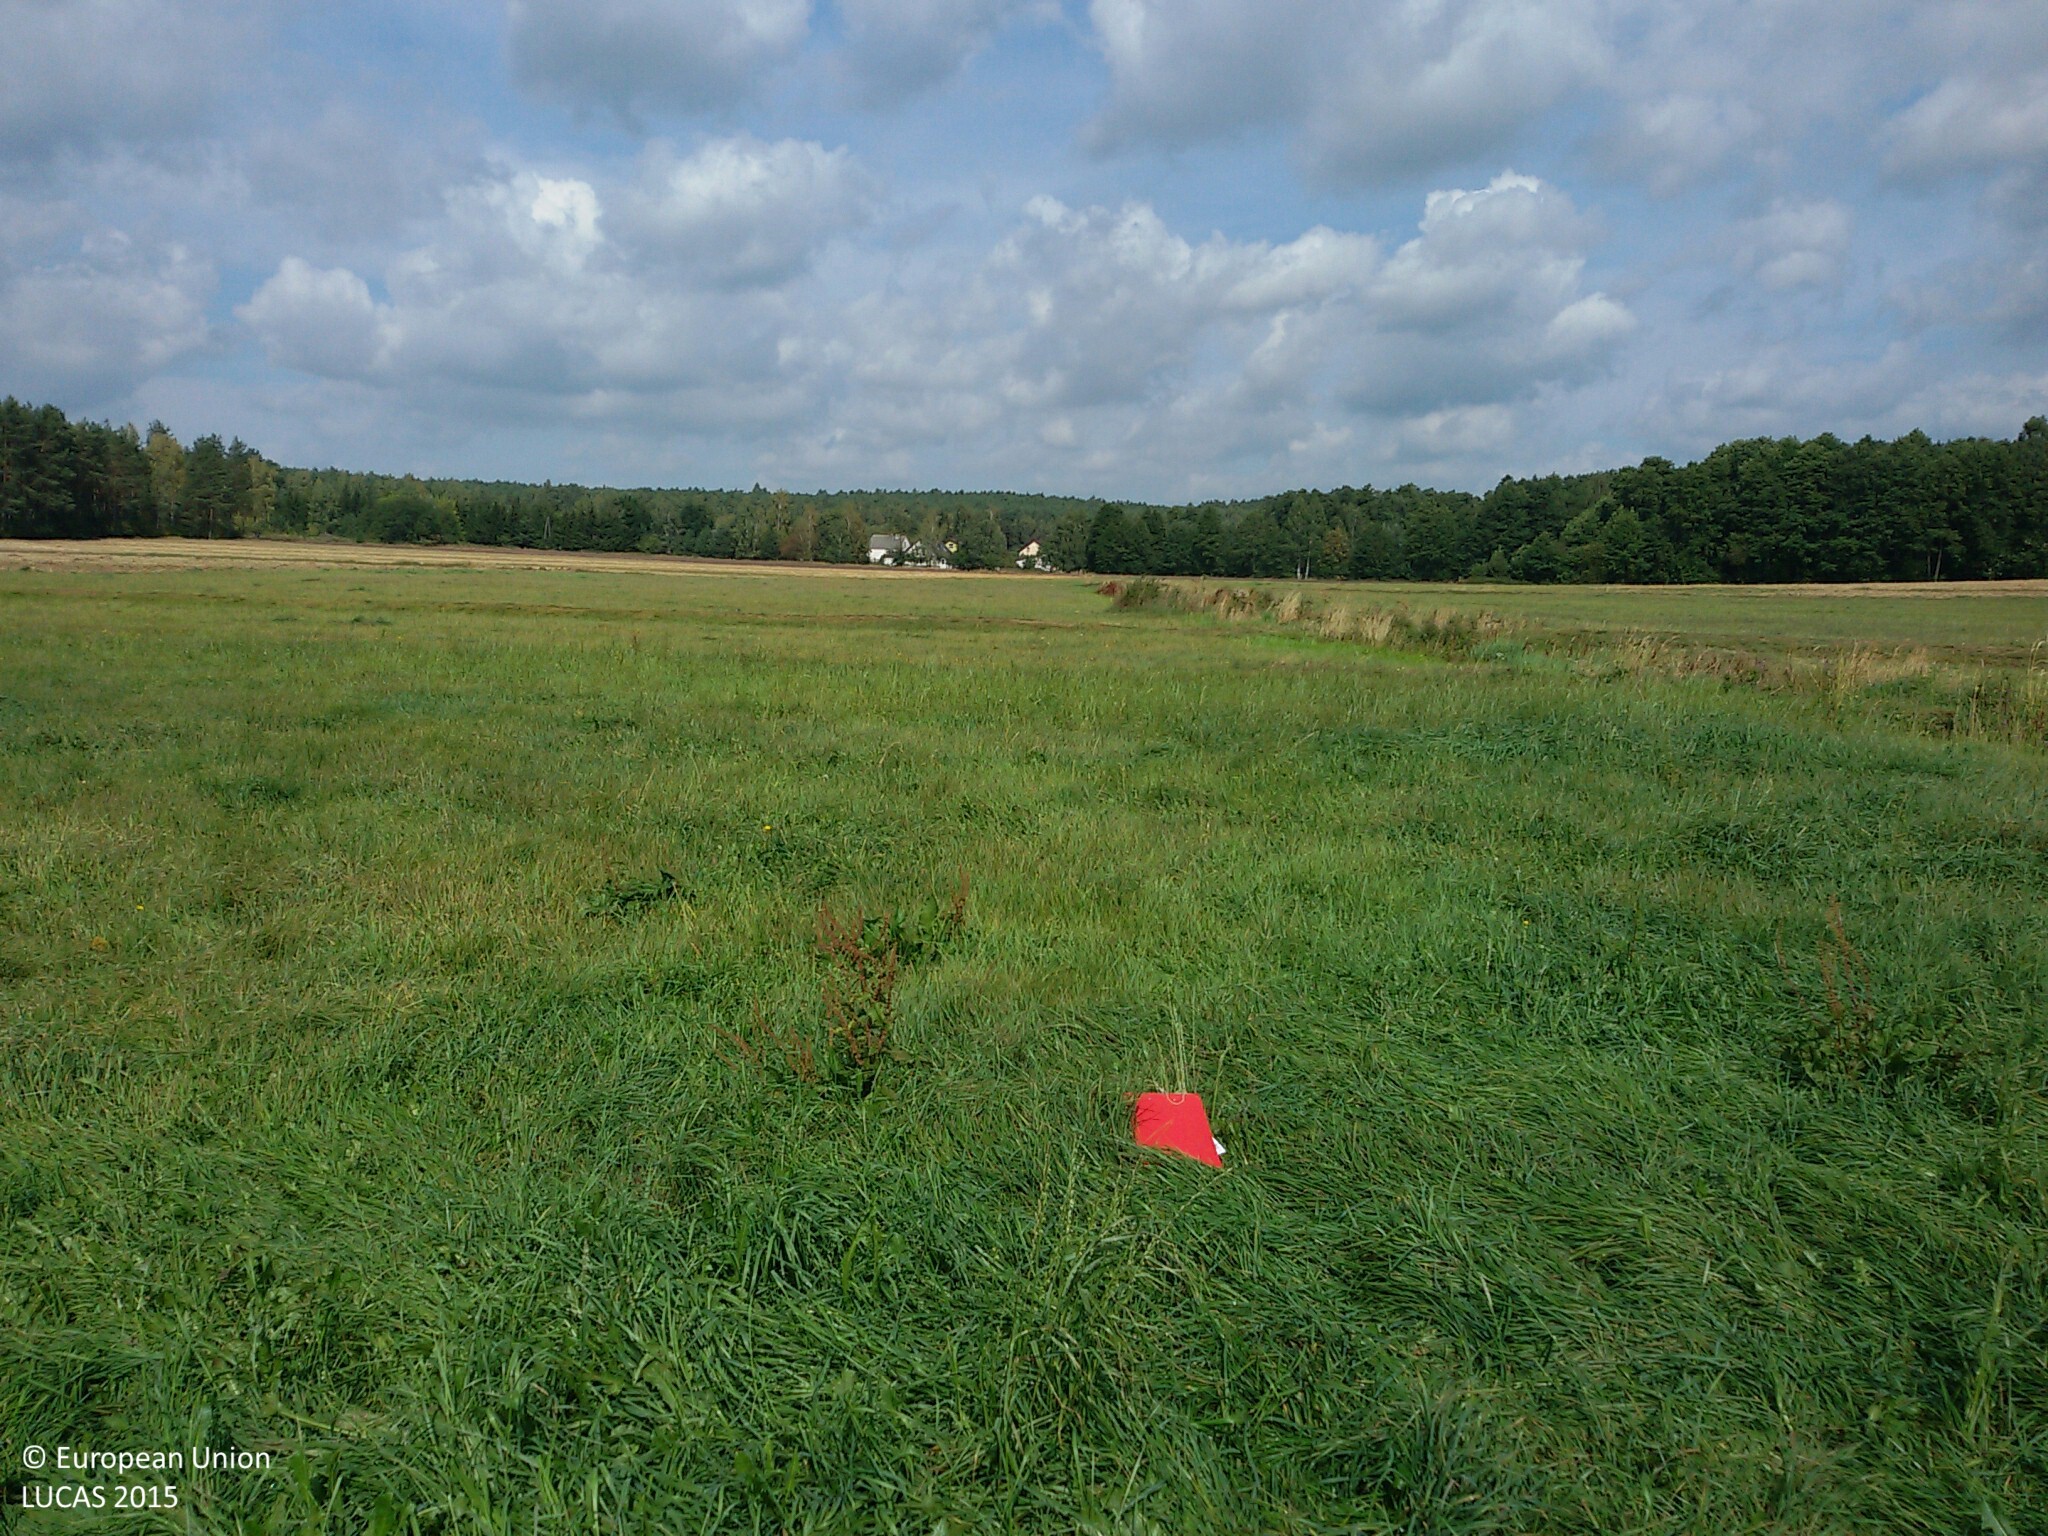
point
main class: Grassland
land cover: Grassland without tree/shrub cover
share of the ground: > 75 %
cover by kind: herbaceous plants 100 %
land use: Agriculture (excluding fallow land and kitchen gardens)
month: August
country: PL
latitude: 52.8204
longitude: 22.0036
